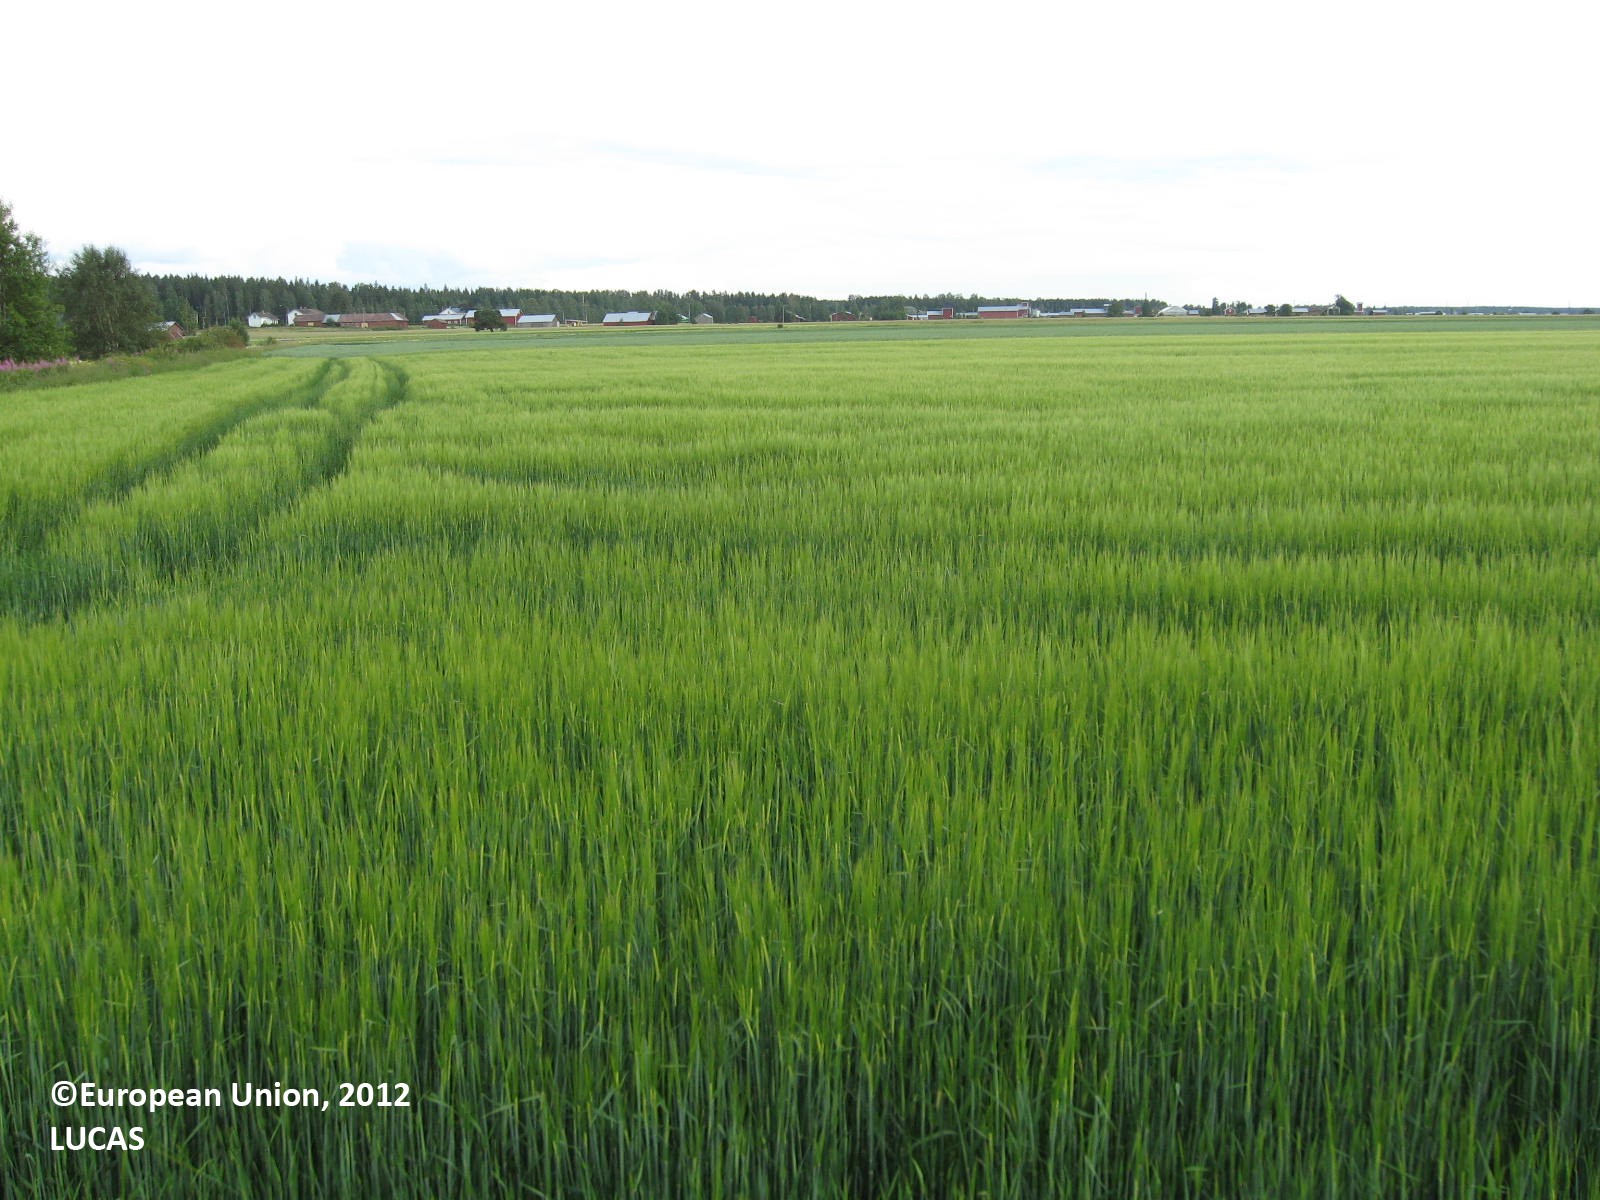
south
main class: Cropland
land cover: Barley
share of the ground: > 75 %
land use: Agriculture (excluding fallow land and kitchen gardens)
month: July
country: FI
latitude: 62.5745
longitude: 21.4661
